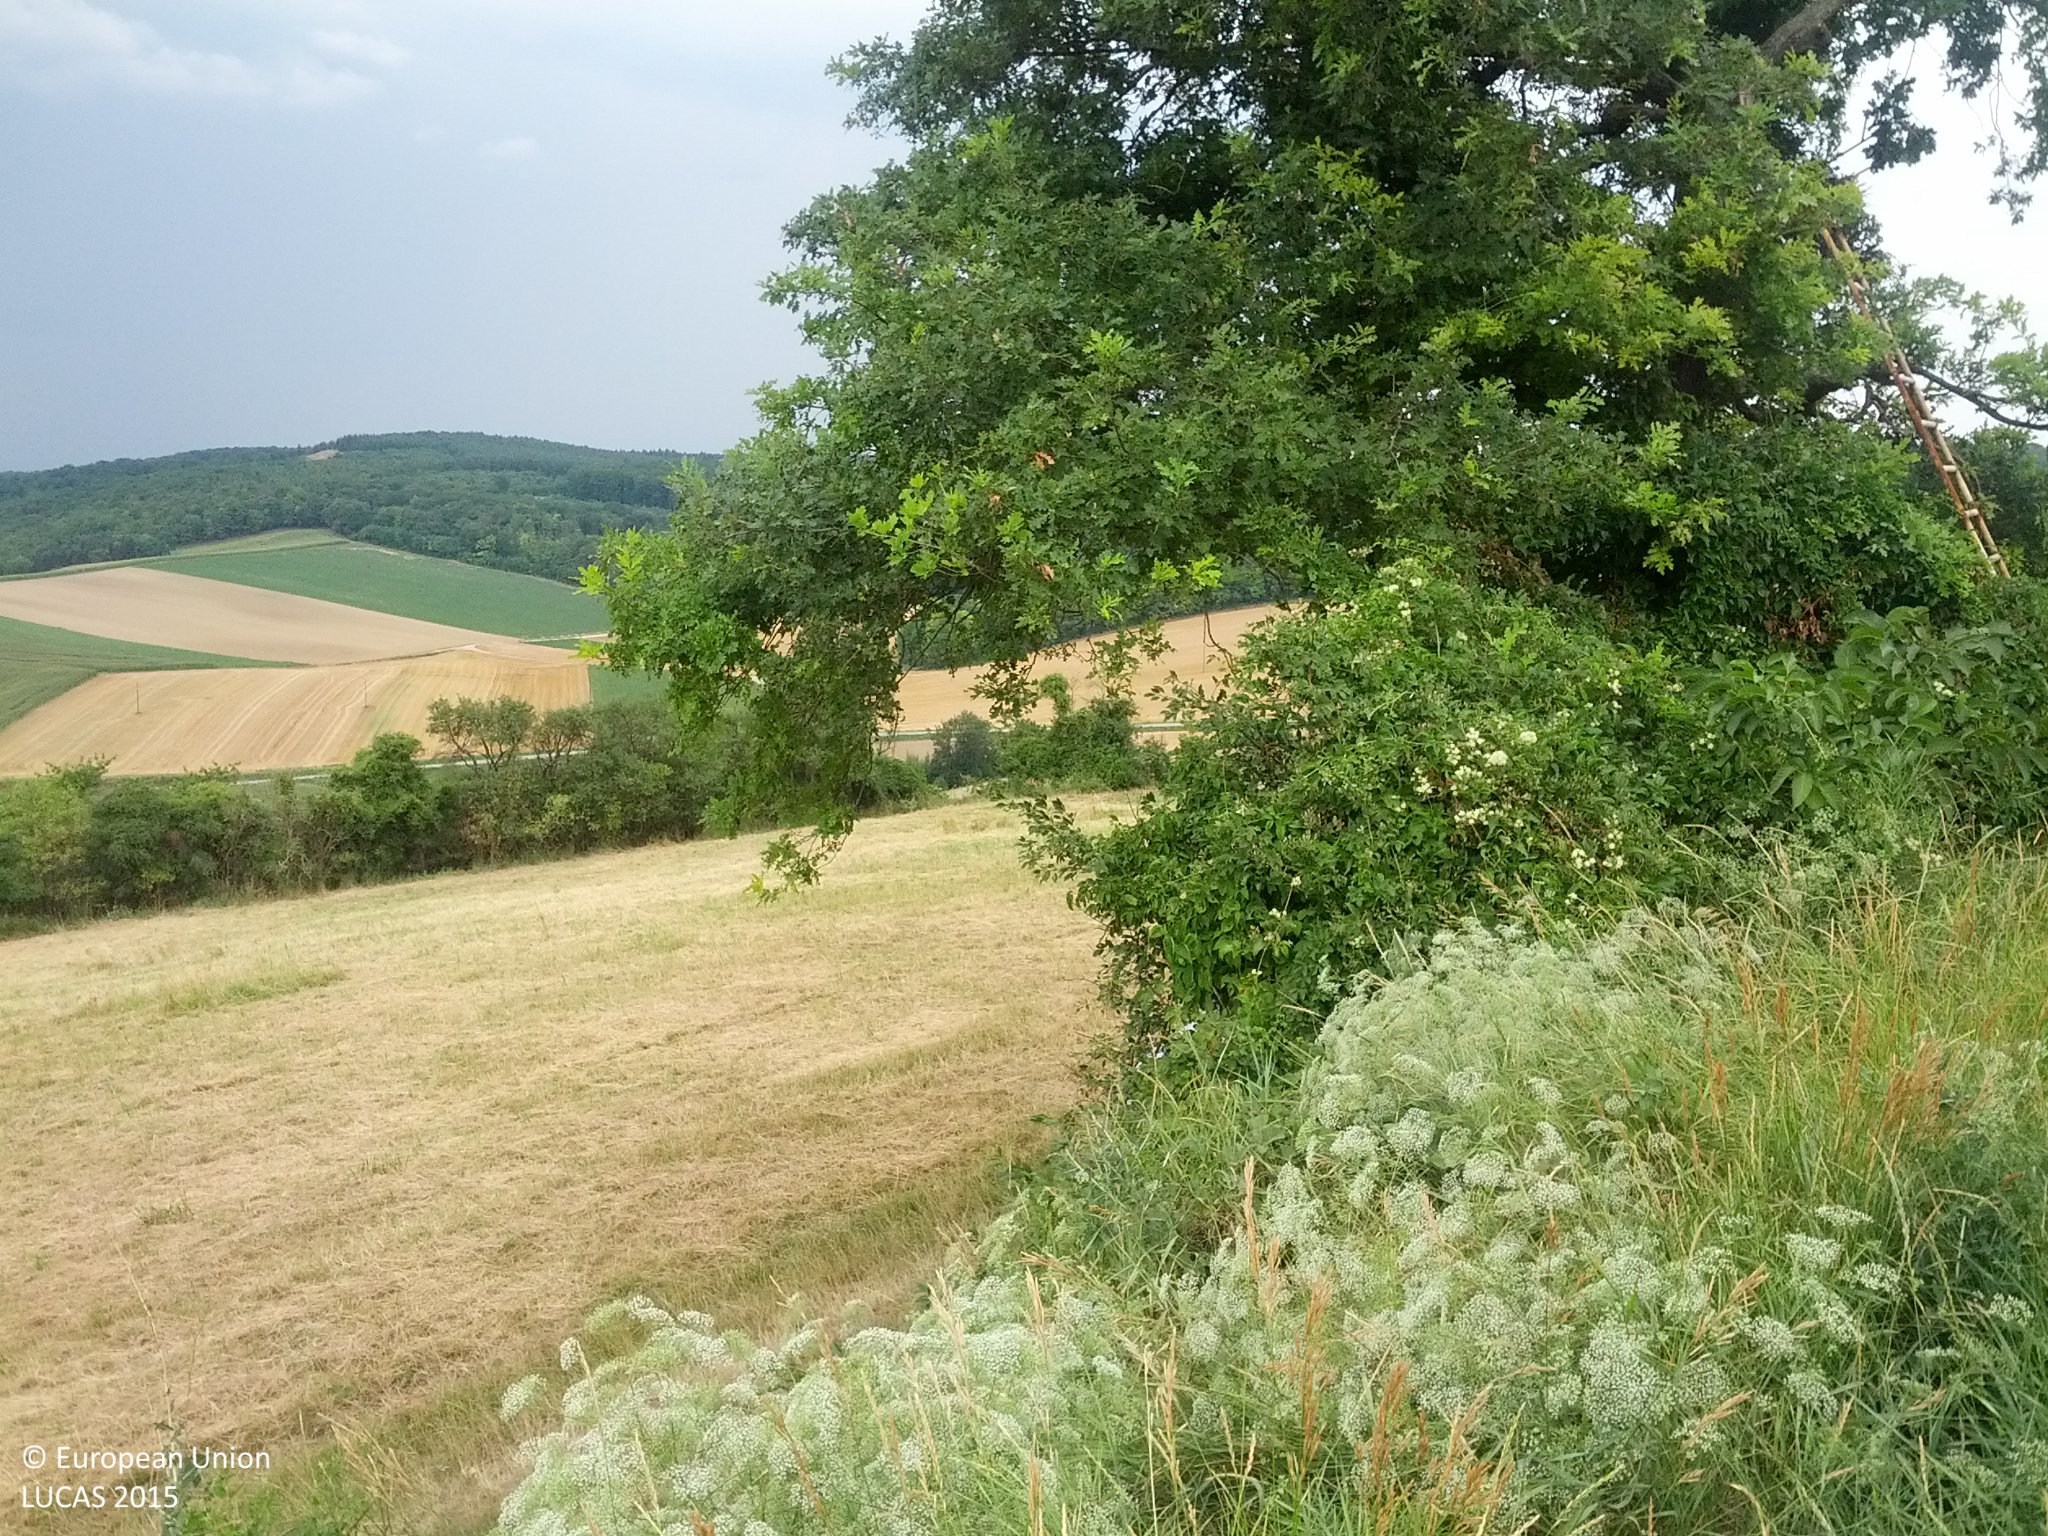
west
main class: Cropland
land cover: Other fibre and oleaginous crops
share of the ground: > 75 %
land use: Agriculture (excluding fallow land and kitchen gardens)
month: July
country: AT
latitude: 48.5202
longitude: 16.1651
